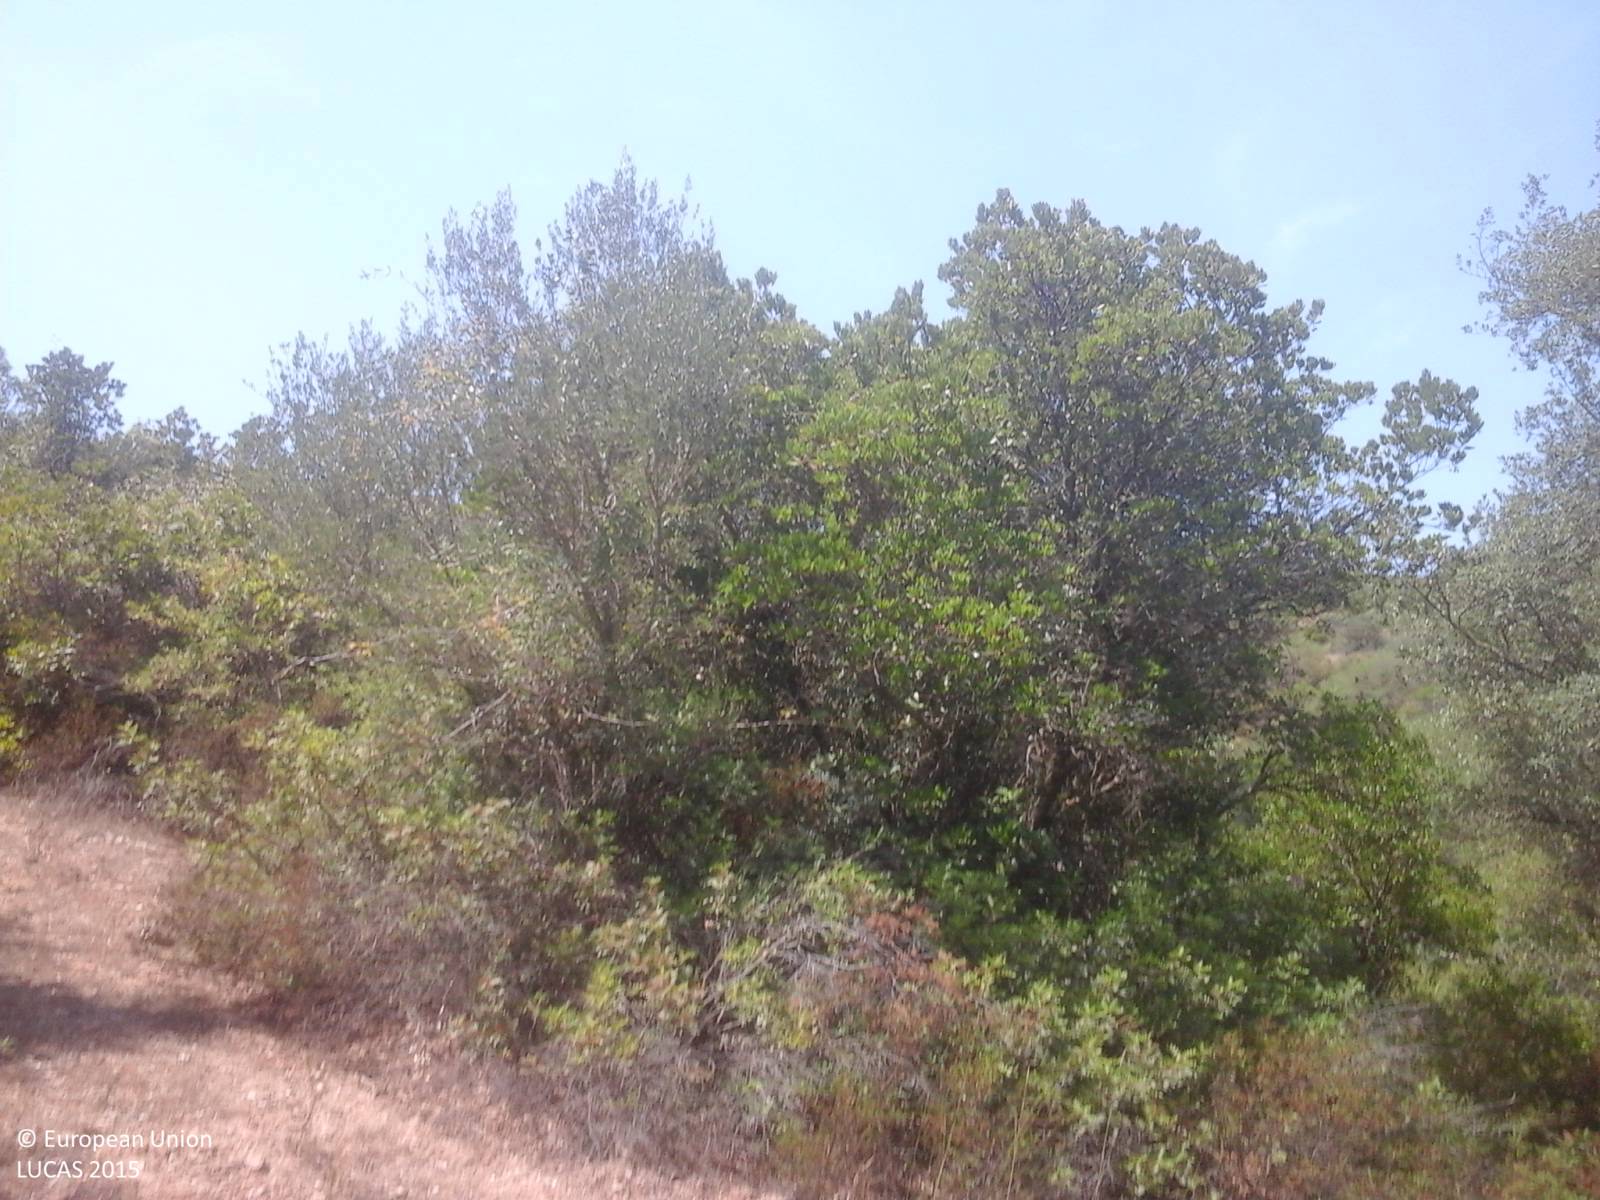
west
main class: Shrubland
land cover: Shrubland with sparse tree cover
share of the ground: > 75 %
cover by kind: shrubs 85 %, herbaceous plants 10 %, broadleaved forest trees 5 %
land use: Agriculture (excluding fallow land and kitchen gardens)
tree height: > 5 m
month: August
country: IT
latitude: 39.6487
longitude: 9.2469
